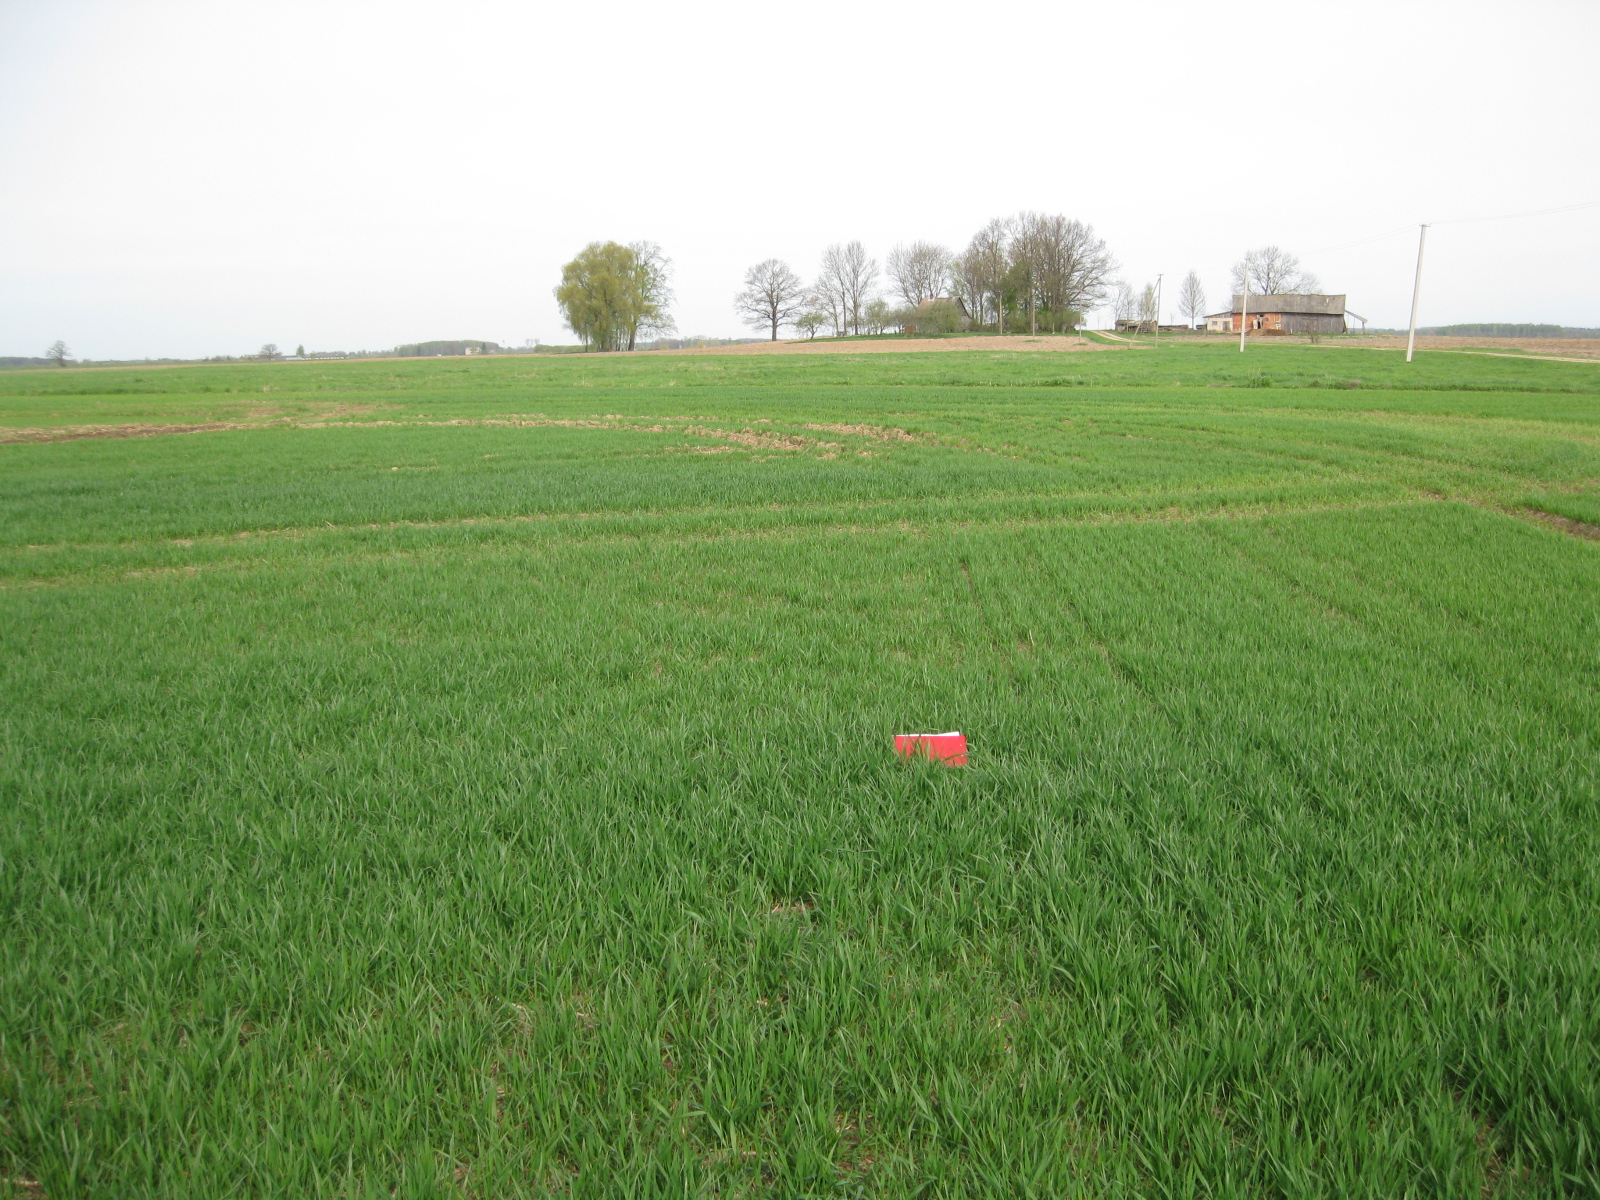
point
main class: Cropland
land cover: Common wheat
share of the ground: > 75 %
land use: Agriculture (excluding fallow land and kitchen gardens)
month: May
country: LT
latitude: 56.2572
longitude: 24.4793
